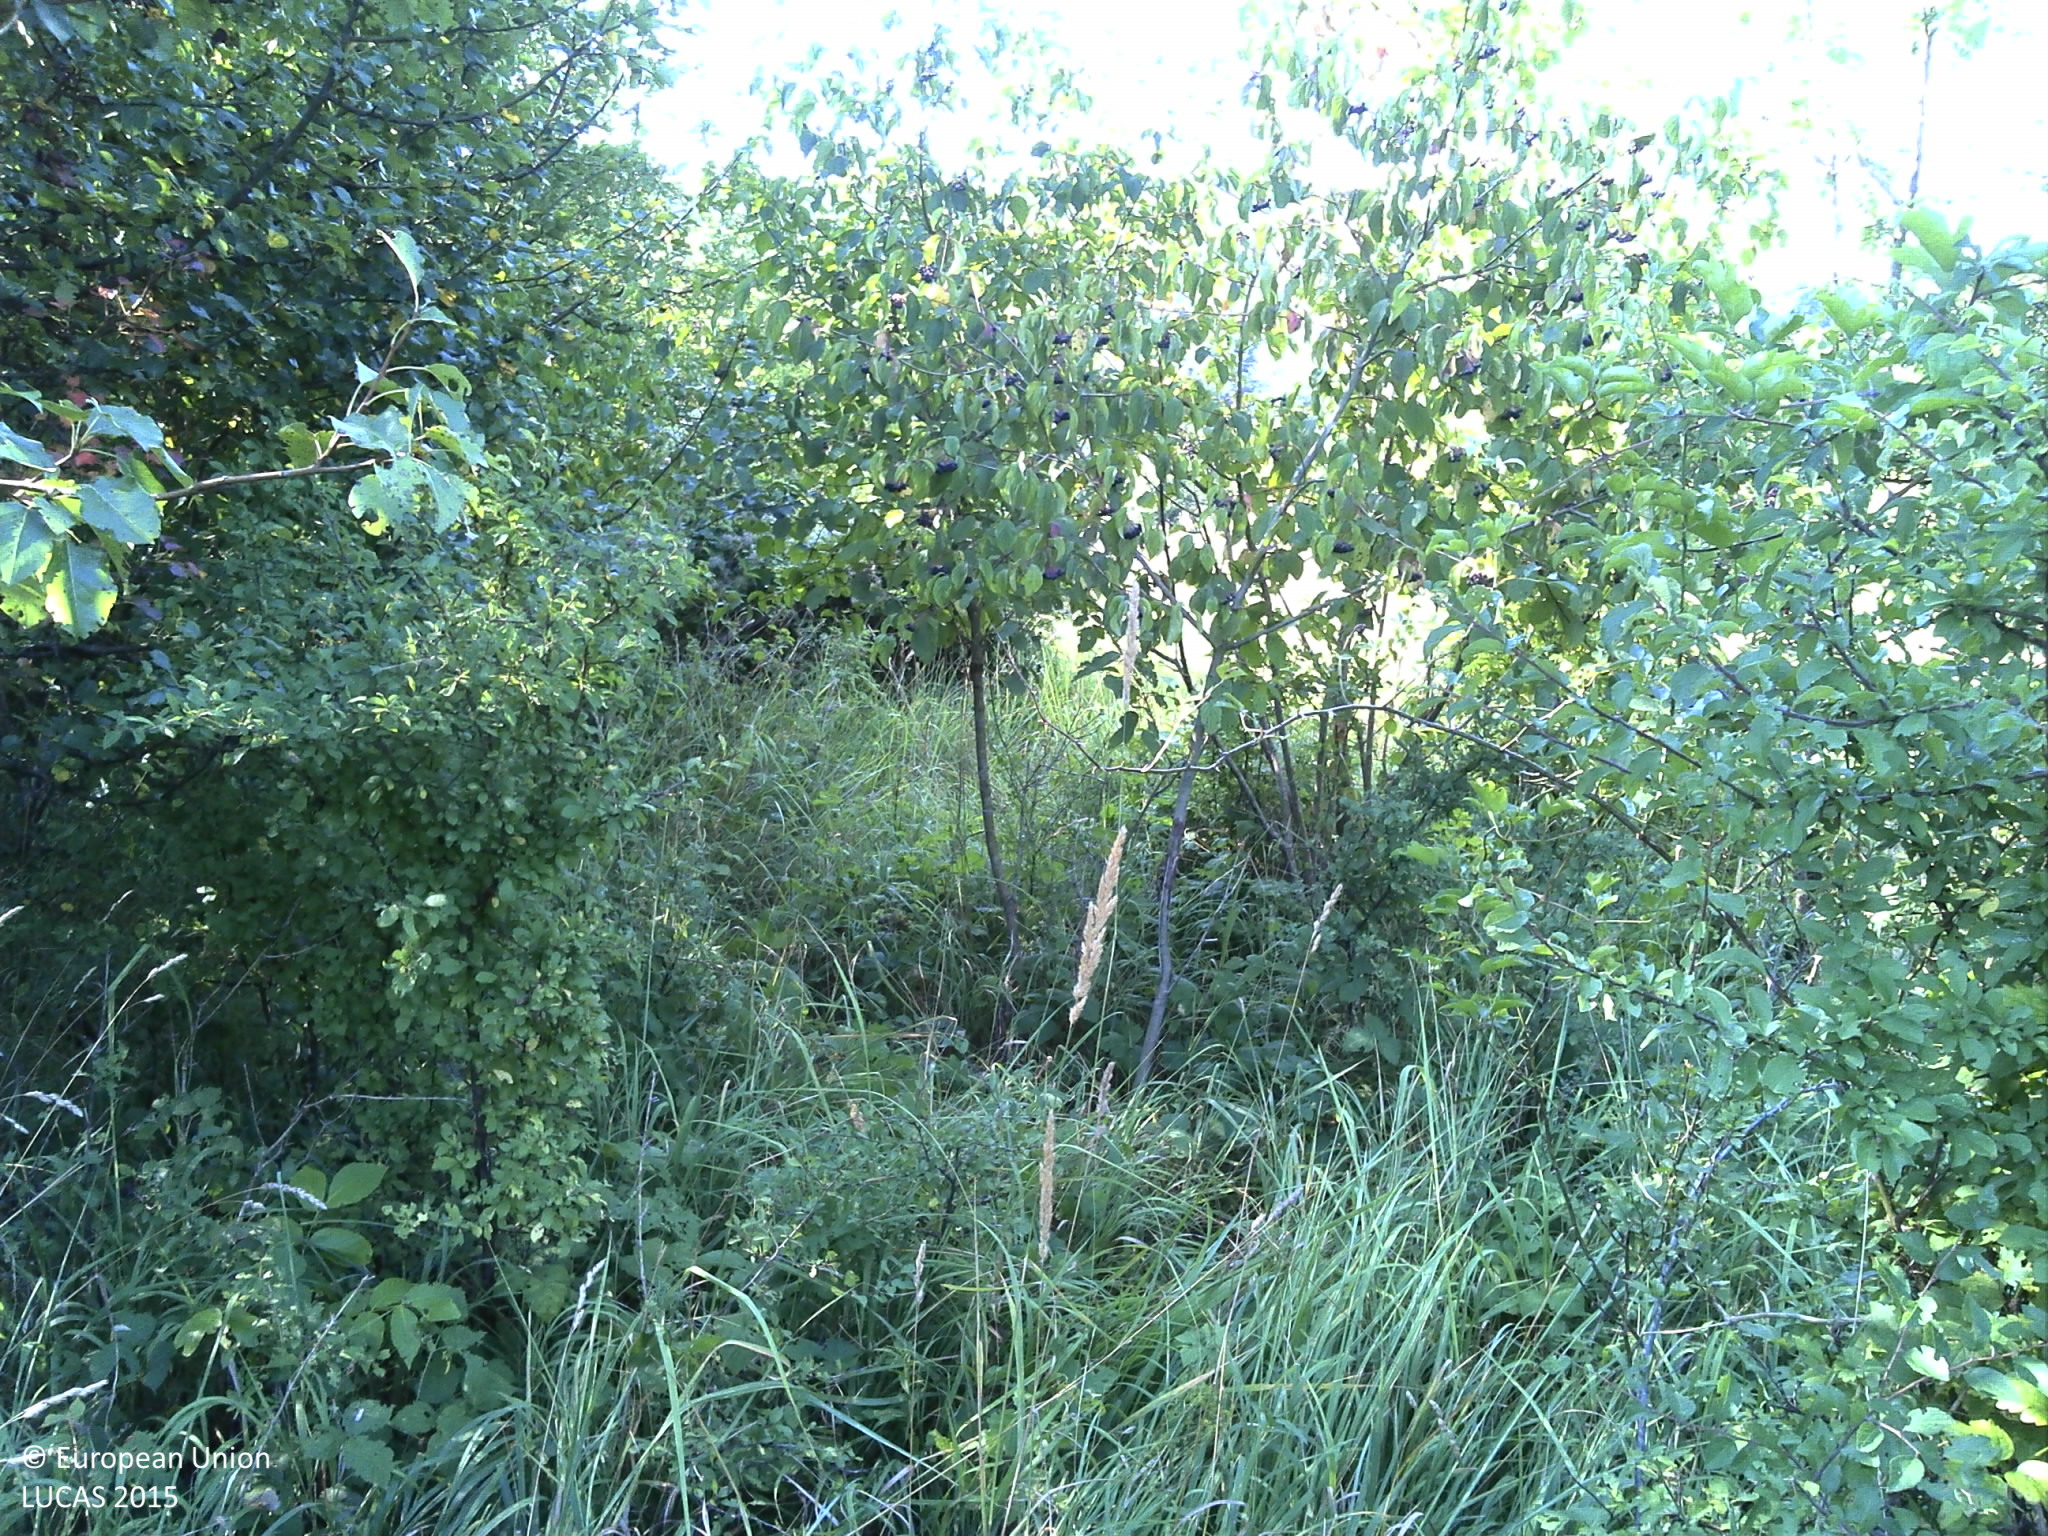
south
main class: Grassland
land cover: Spontaneously vegetated surfaces
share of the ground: > 75 %
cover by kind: herbaceous plants 100 %
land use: Semi-natural and natural areas not in use
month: August
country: HR
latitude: 45.5615
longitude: 17.2650
